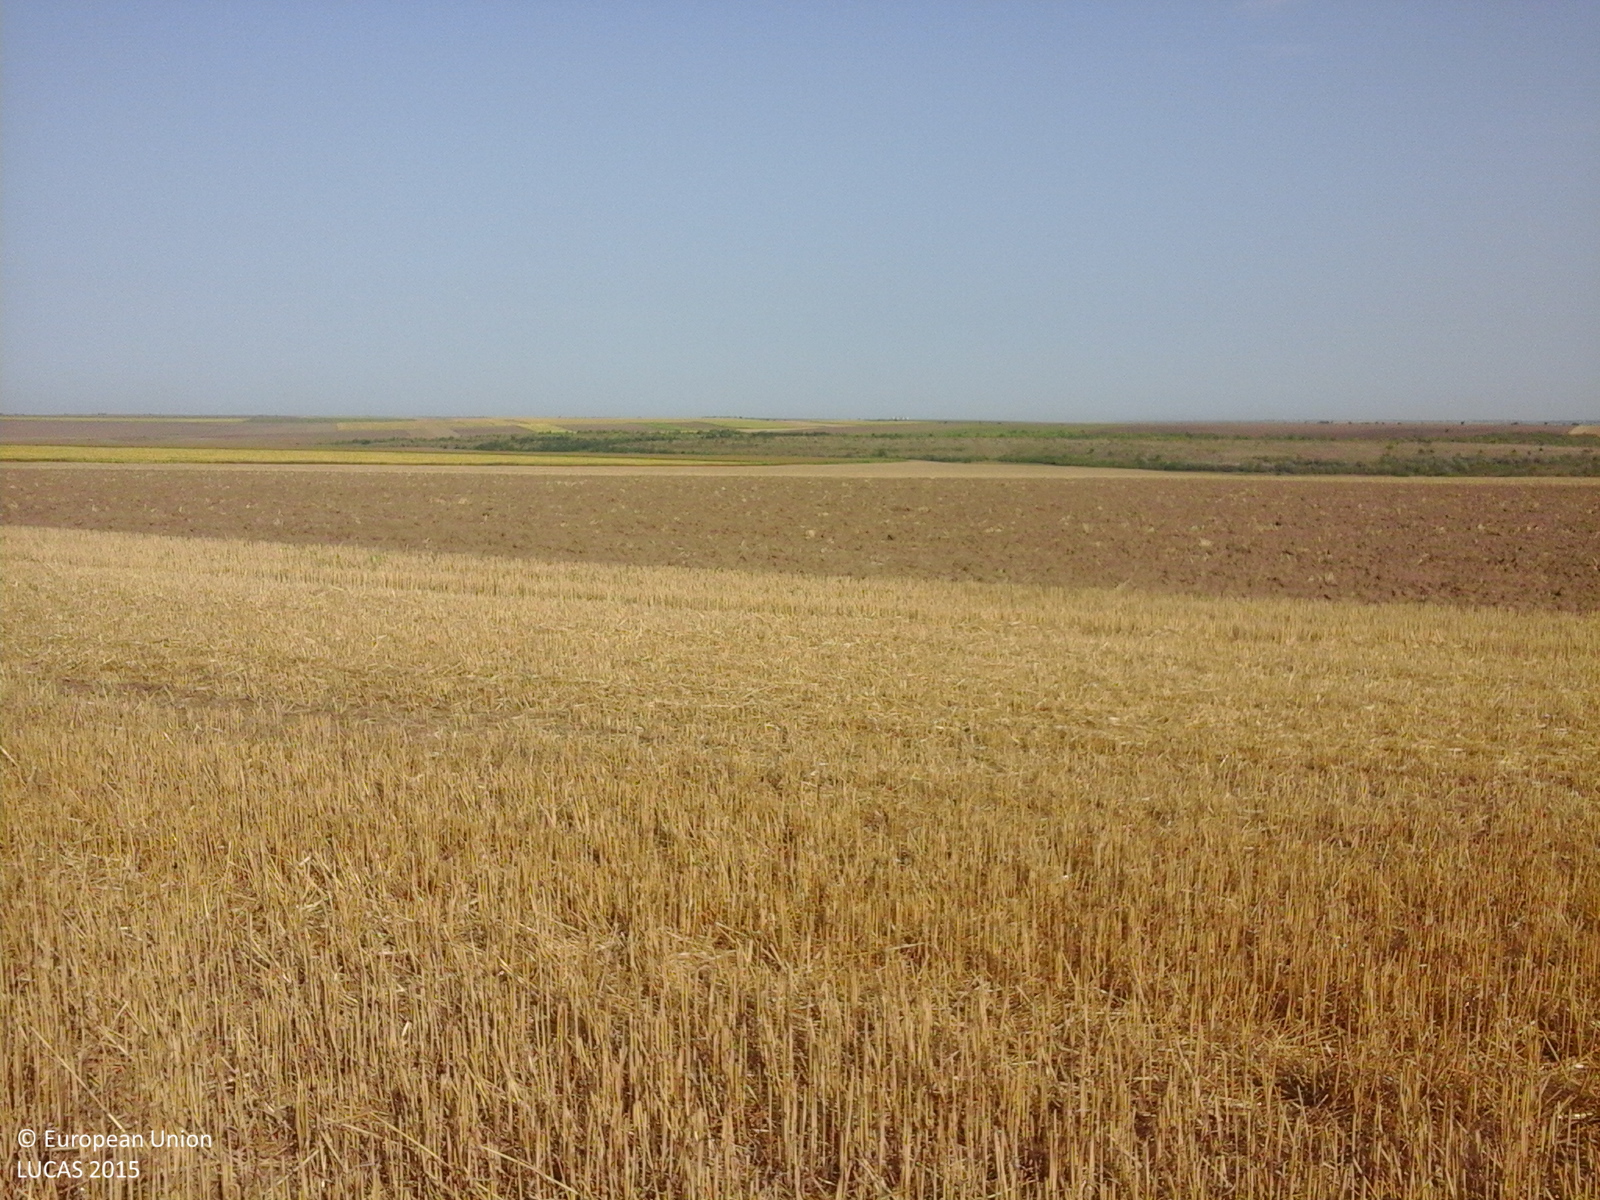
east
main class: Cropland
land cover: Common wheat
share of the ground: > 75 %
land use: Agriculture (excluding fallow land and kitchen gardens)
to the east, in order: Common wheat
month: August
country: RO
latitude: 44.0363
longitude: 28.2926
